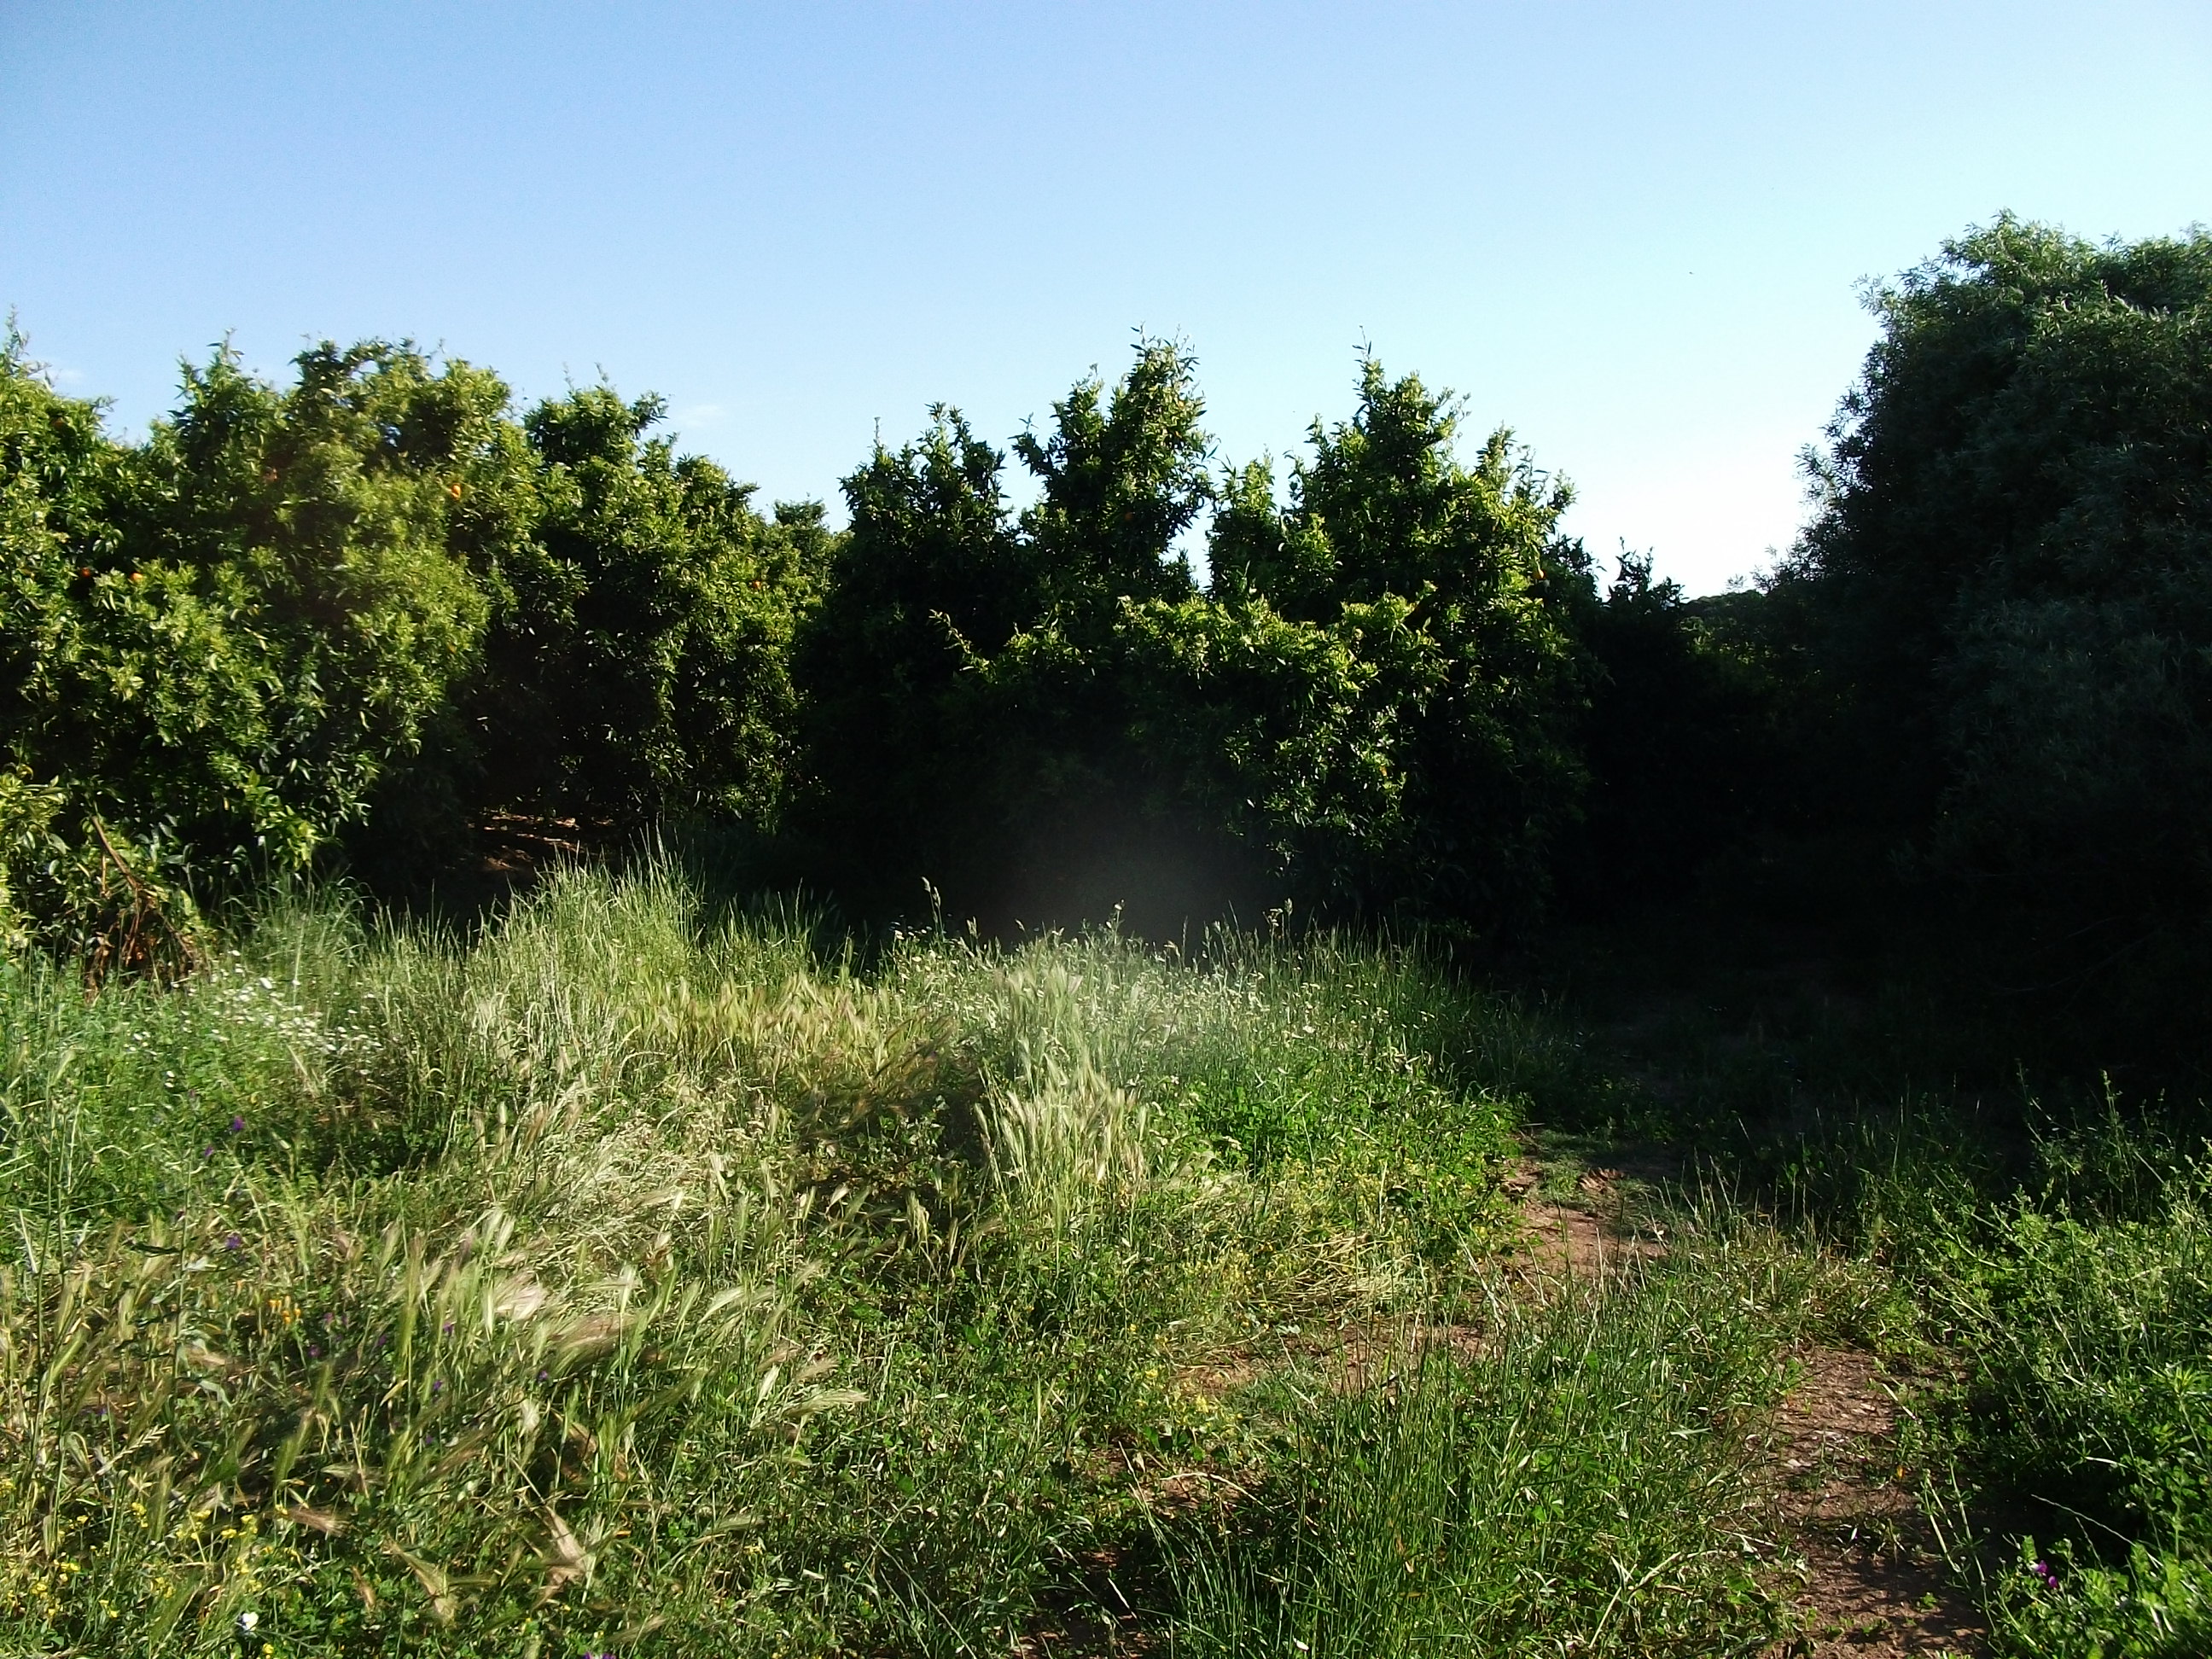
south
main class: Shrubland
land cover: Shrubland without tree cover
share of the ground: > 75 %
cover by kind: shrubs 100 %
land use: Semi-natural and natural areas not in use
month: April
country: ES
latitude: 37.6616
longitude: -6.6016
